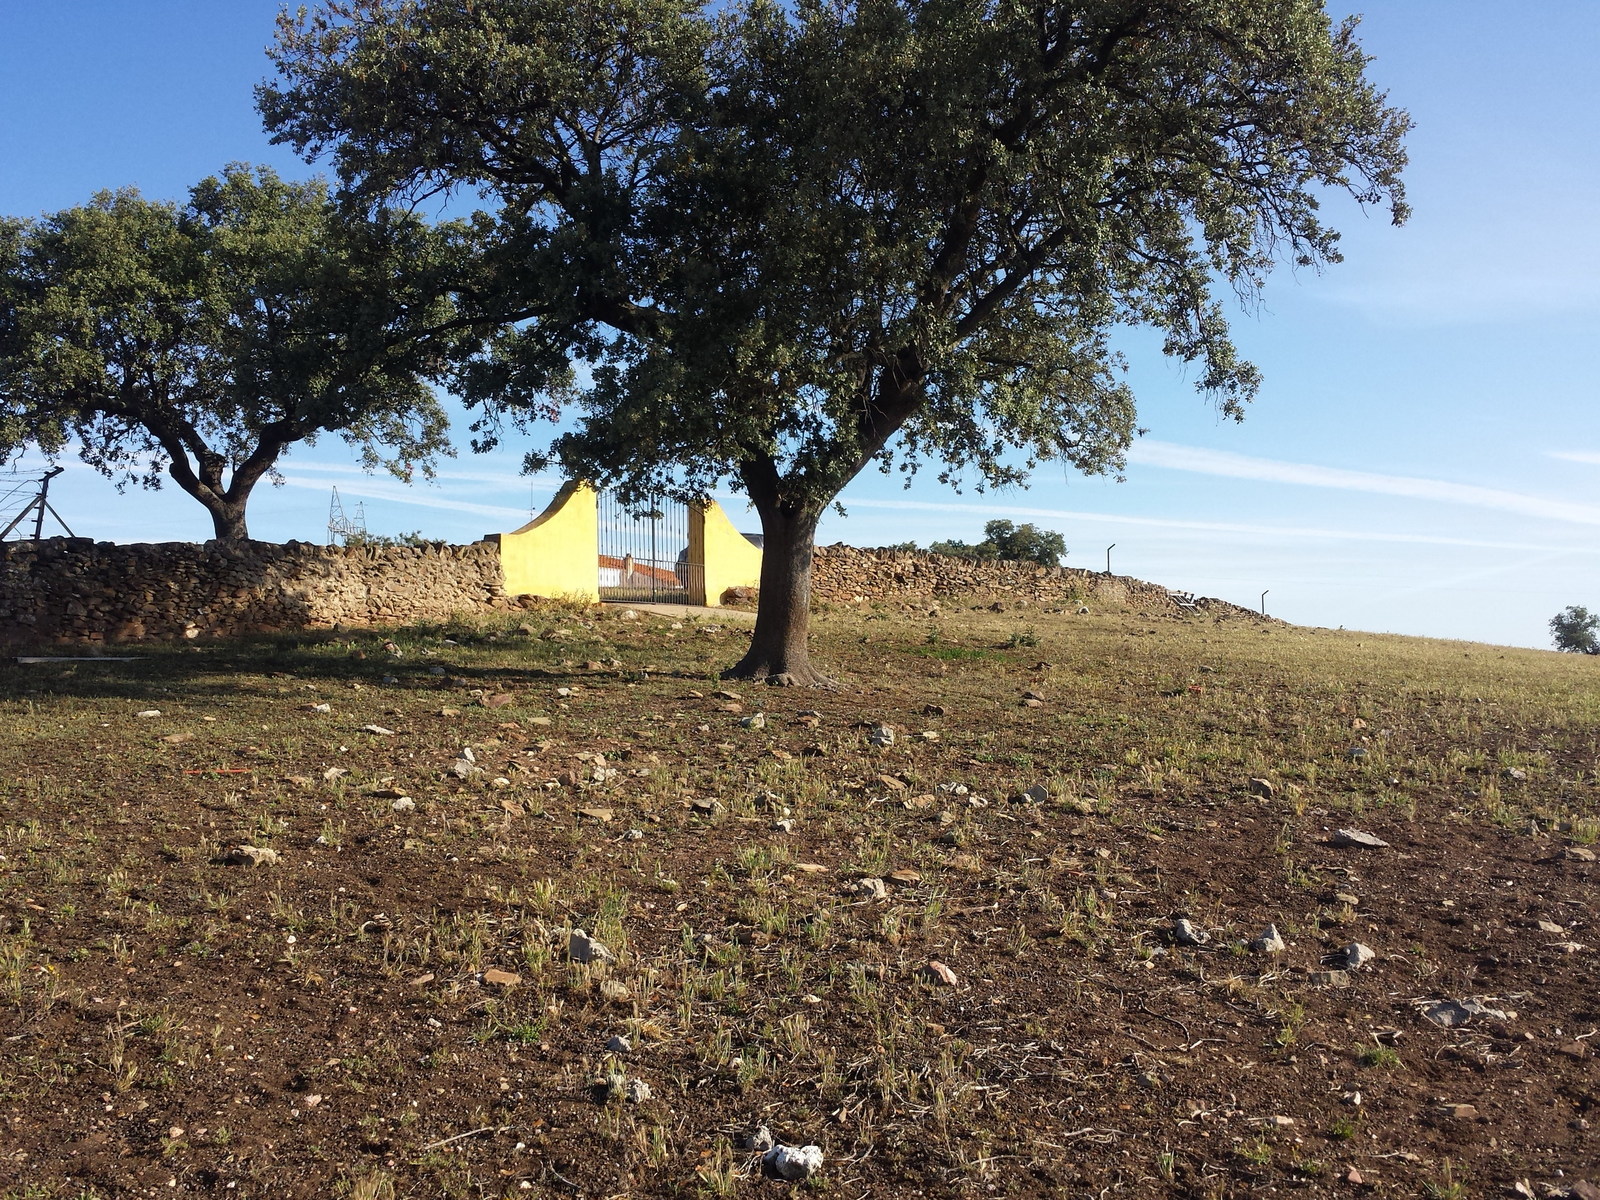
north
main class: Grassland
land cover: Grassland with sparse tree/shrub cover
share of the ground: > 75 %
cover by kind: herbaceous plants 90 %, broadleaved forest trees 5 %
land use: Agriculture (excluding fallow land and kitchen gardens)
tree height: > 5 m
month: May
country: ES
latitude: 39.6384
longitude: -7.2058
